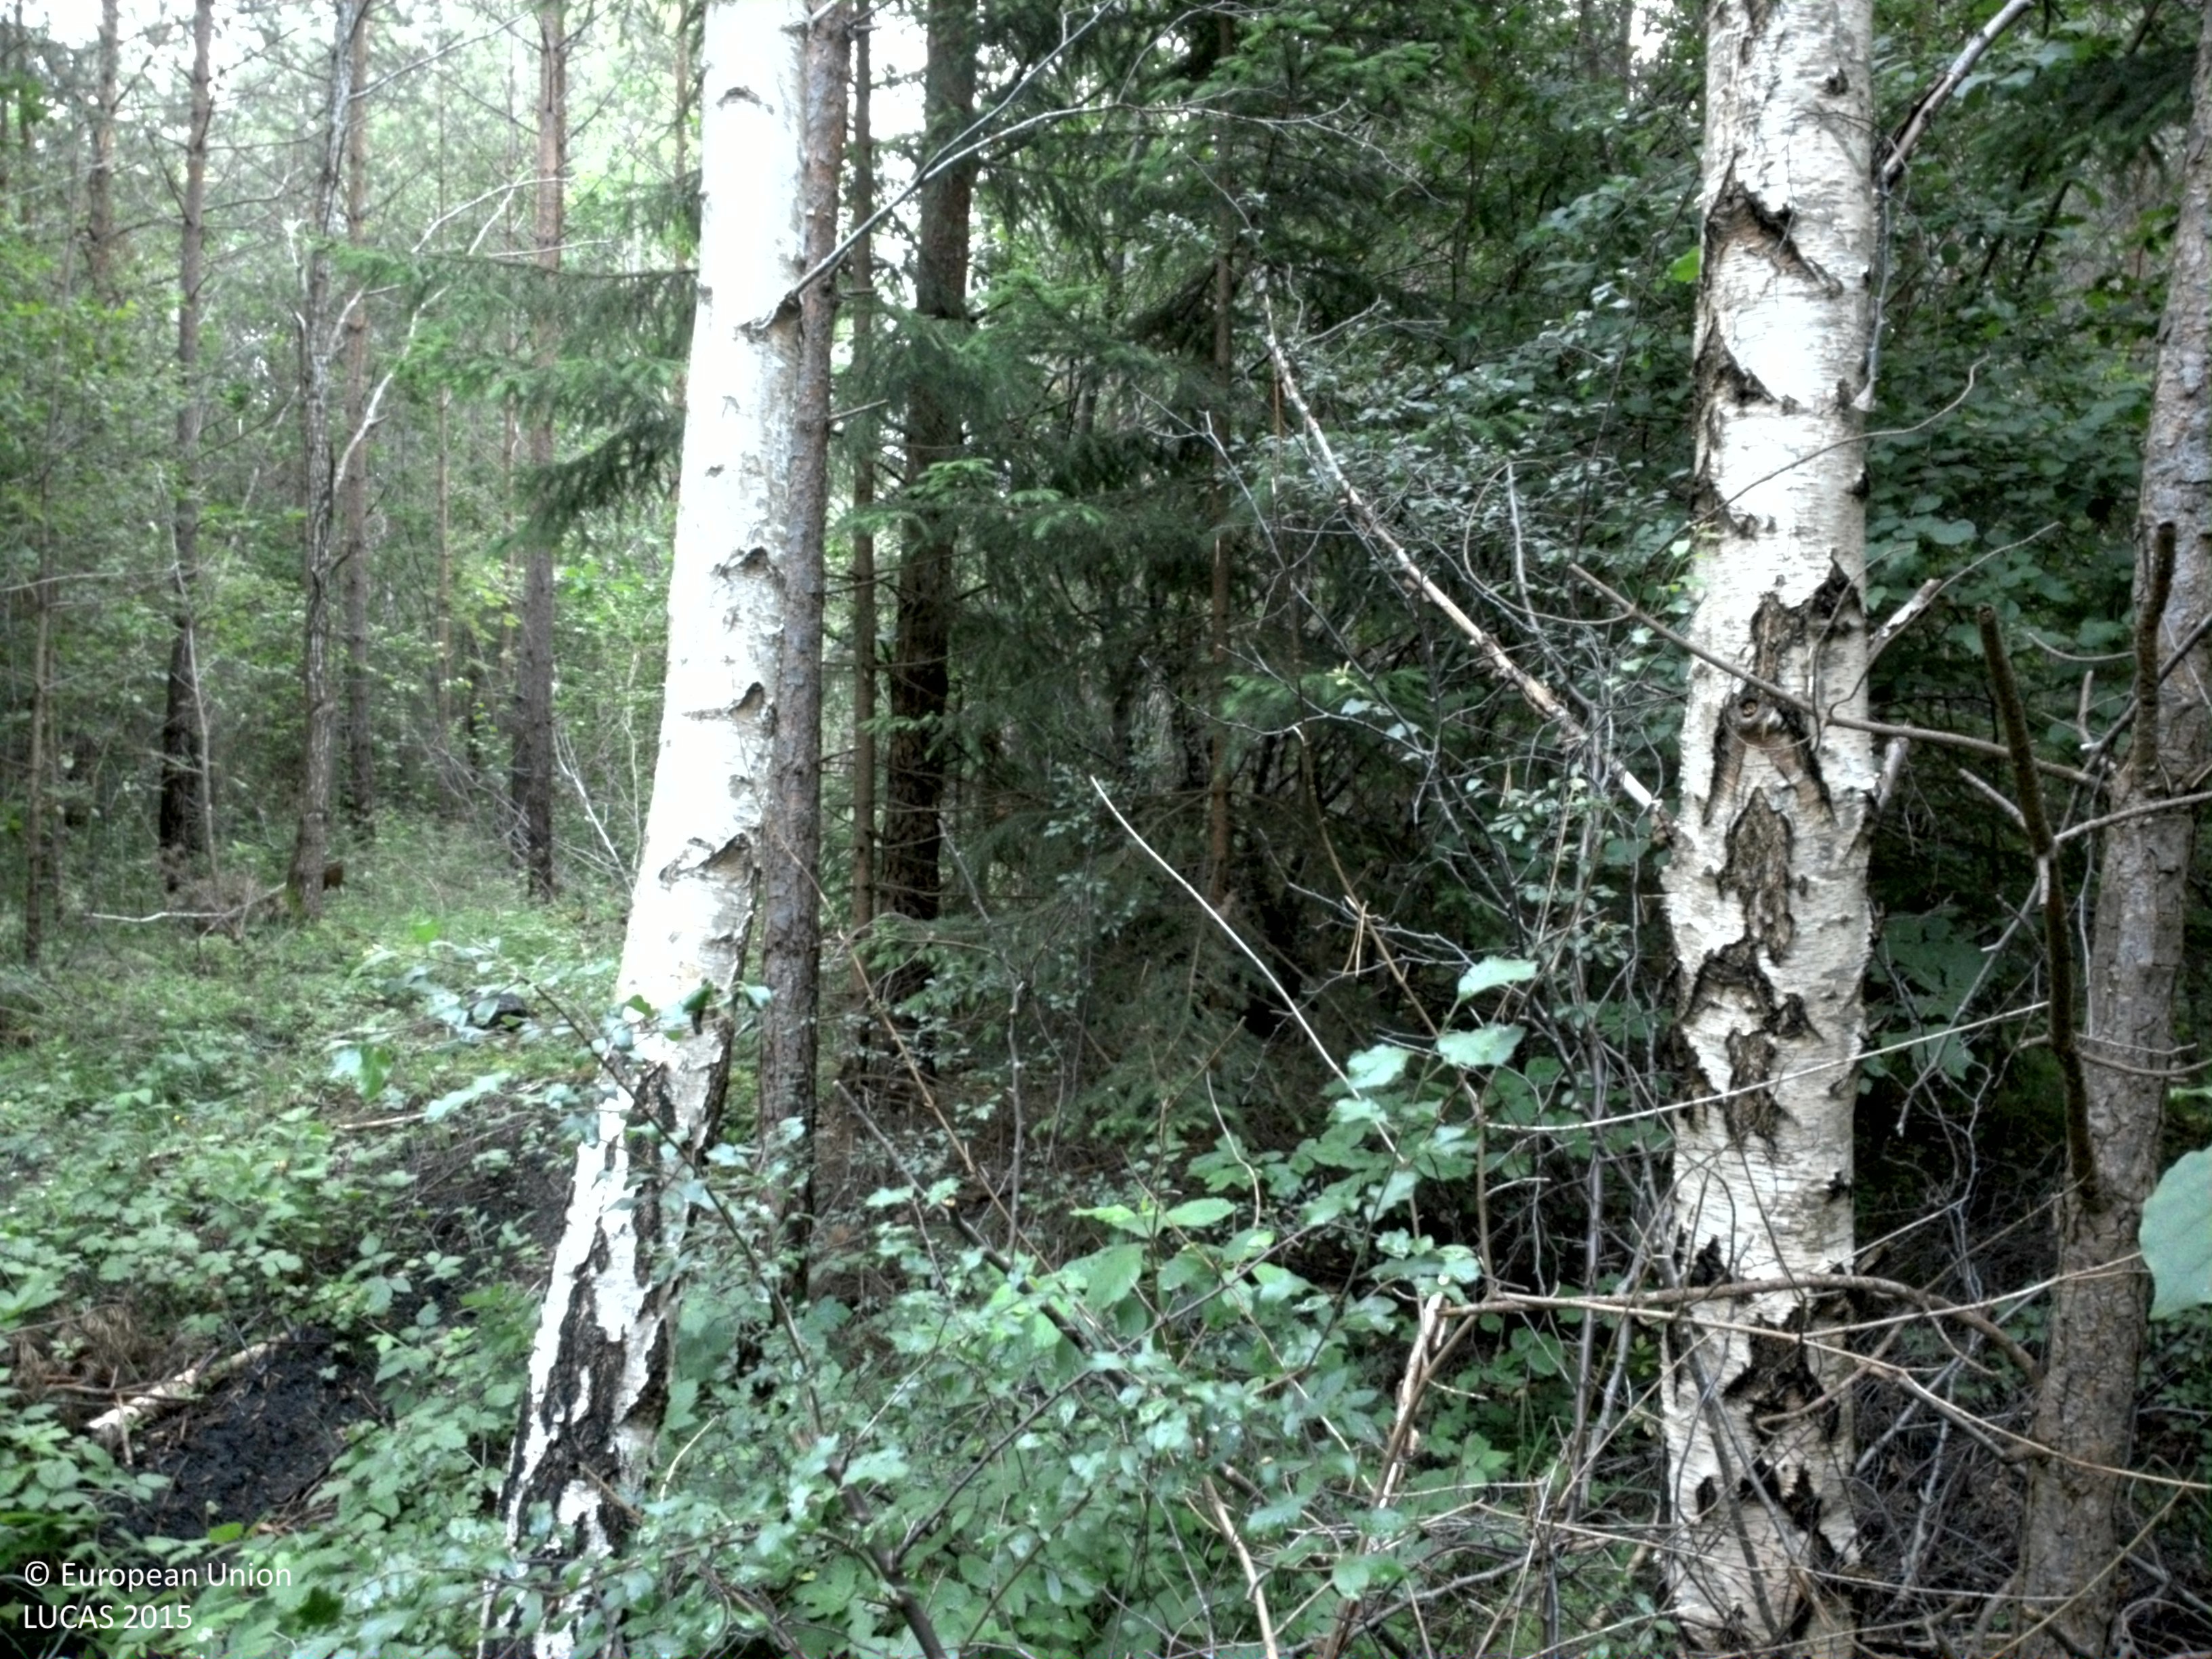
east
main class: Woodland
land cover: Pine dominated mixed woodland
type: hemiboreal forest and nemoral coniferous forest and mixed broadleaved-coniferous forest
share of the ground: > 75 %
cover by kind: coniferous forest trees 55 %, broadleaved forest trees 25 %, herbaceous plants 15 %, unconsolidated bare surface 5 %
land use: Forestry
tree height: > 5 m
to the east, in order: Pine dominated mixed woodland; Spruce dominated coniferous woodland; Tracks; Spruce dominated coniferous woodland; Pine dominated mixed woodland; Groves; Inland marshes
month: July
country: SE
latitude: 57.4051
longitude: 18.2462
